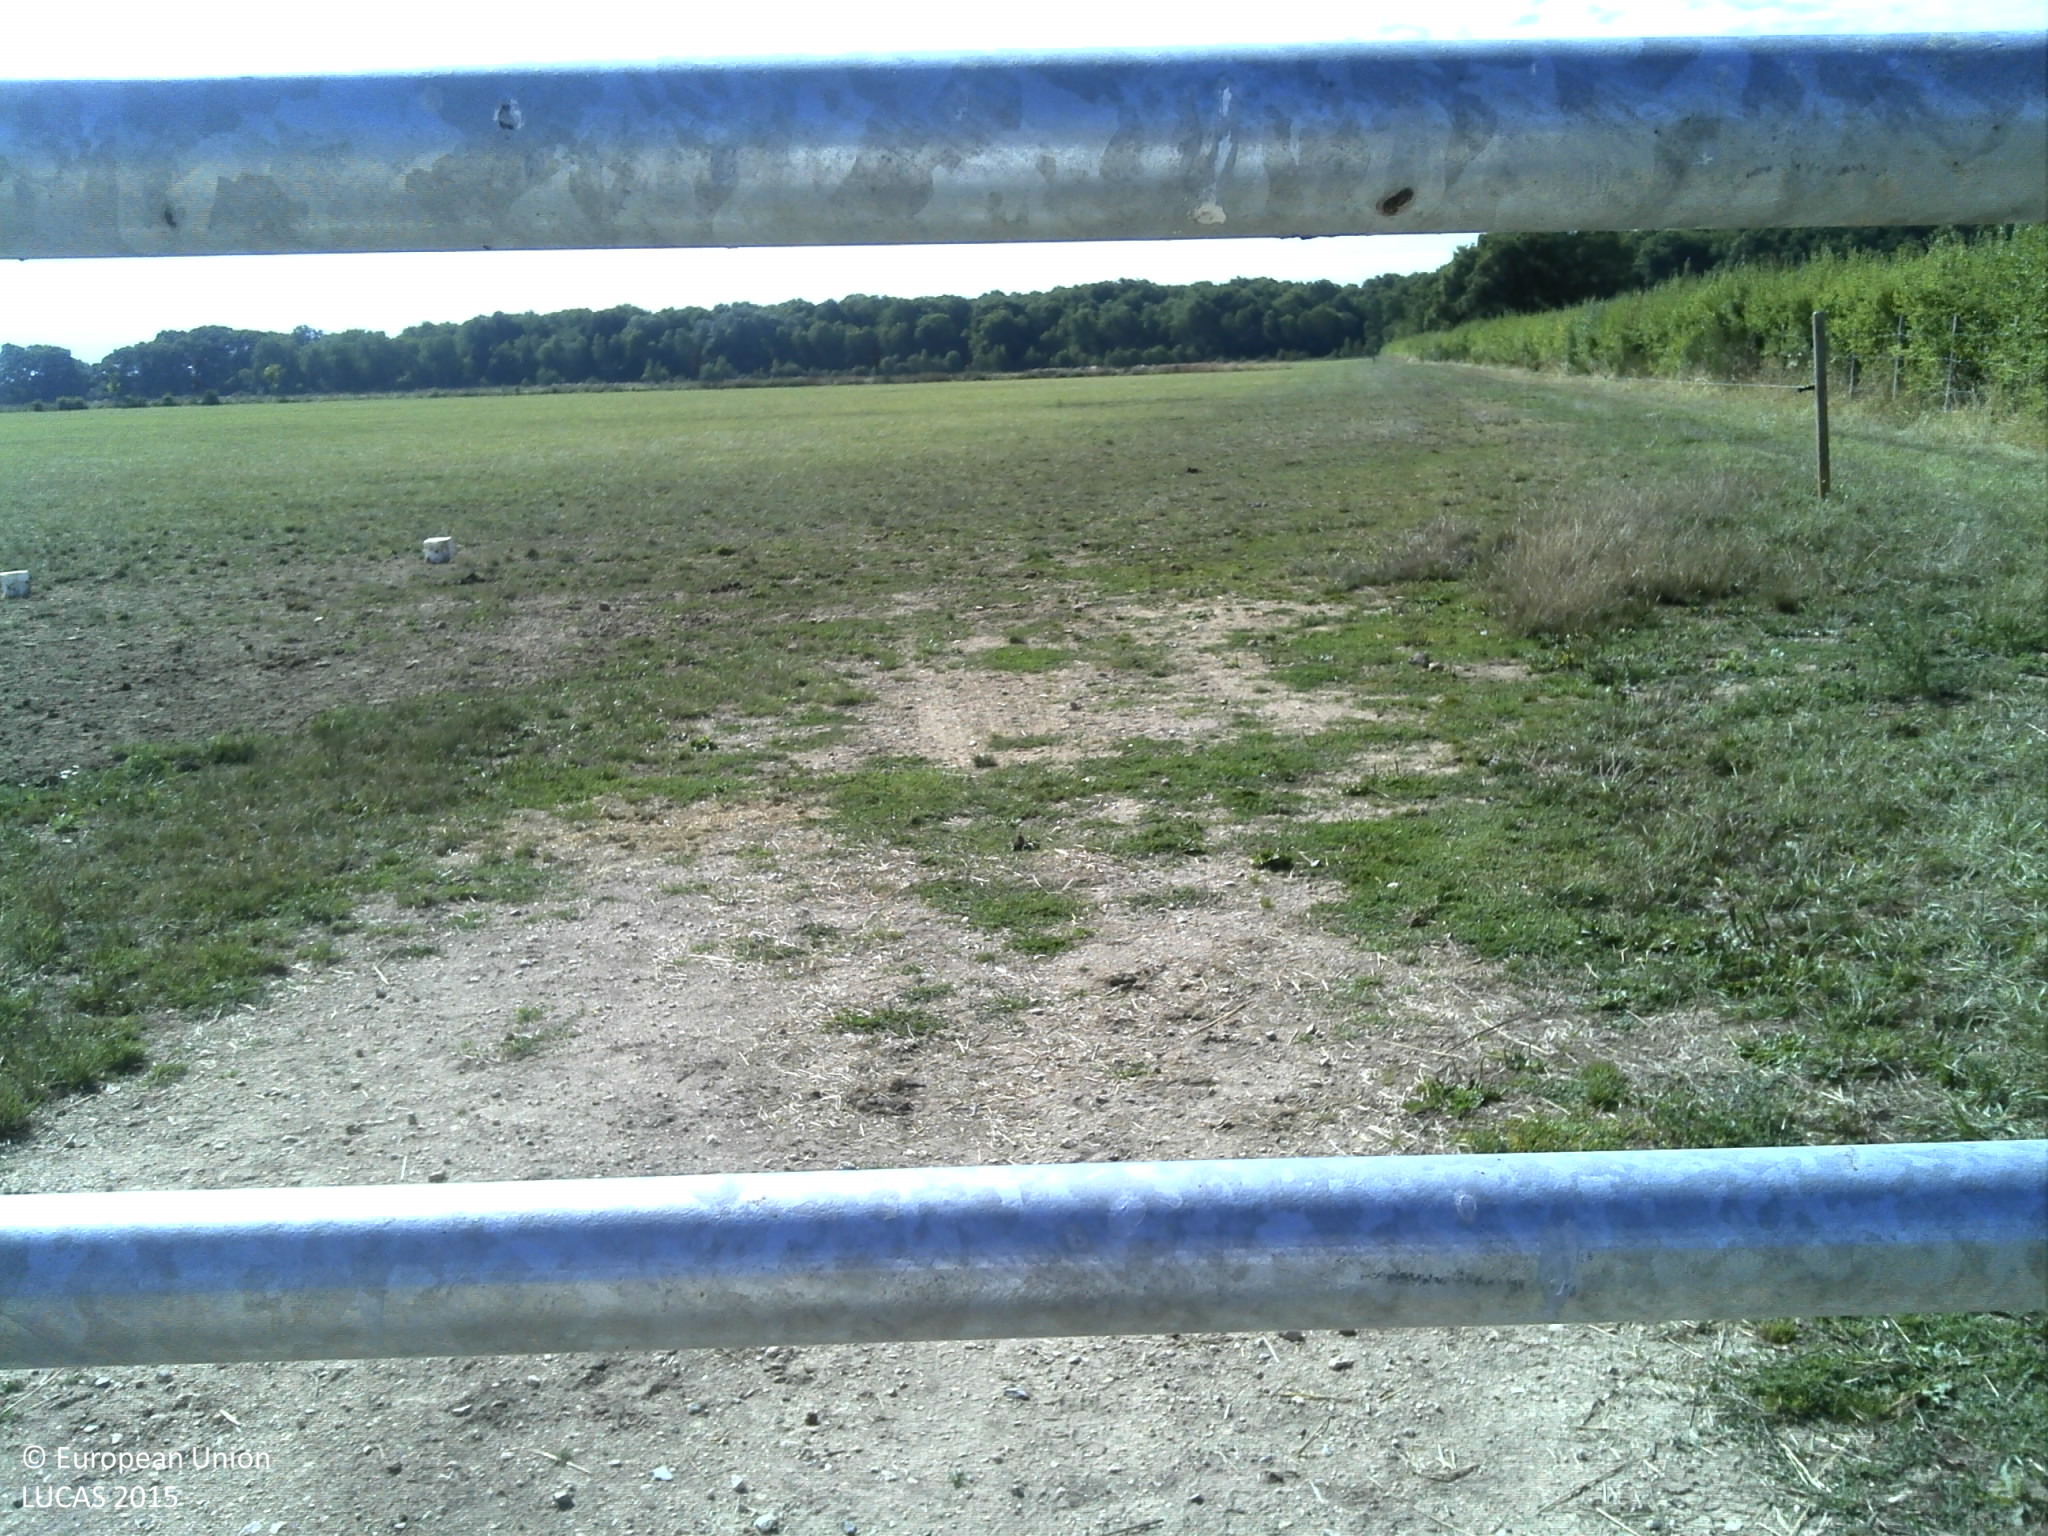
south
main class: Grassland
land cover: Grassland without tree/shrub cover
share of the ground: > 75 %
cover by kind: herbaceous plants 100 %
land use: Agriculture (excluding fallow land and kitchen gardens)
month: August
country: FR
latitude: 48.6670
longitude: 1.9064
